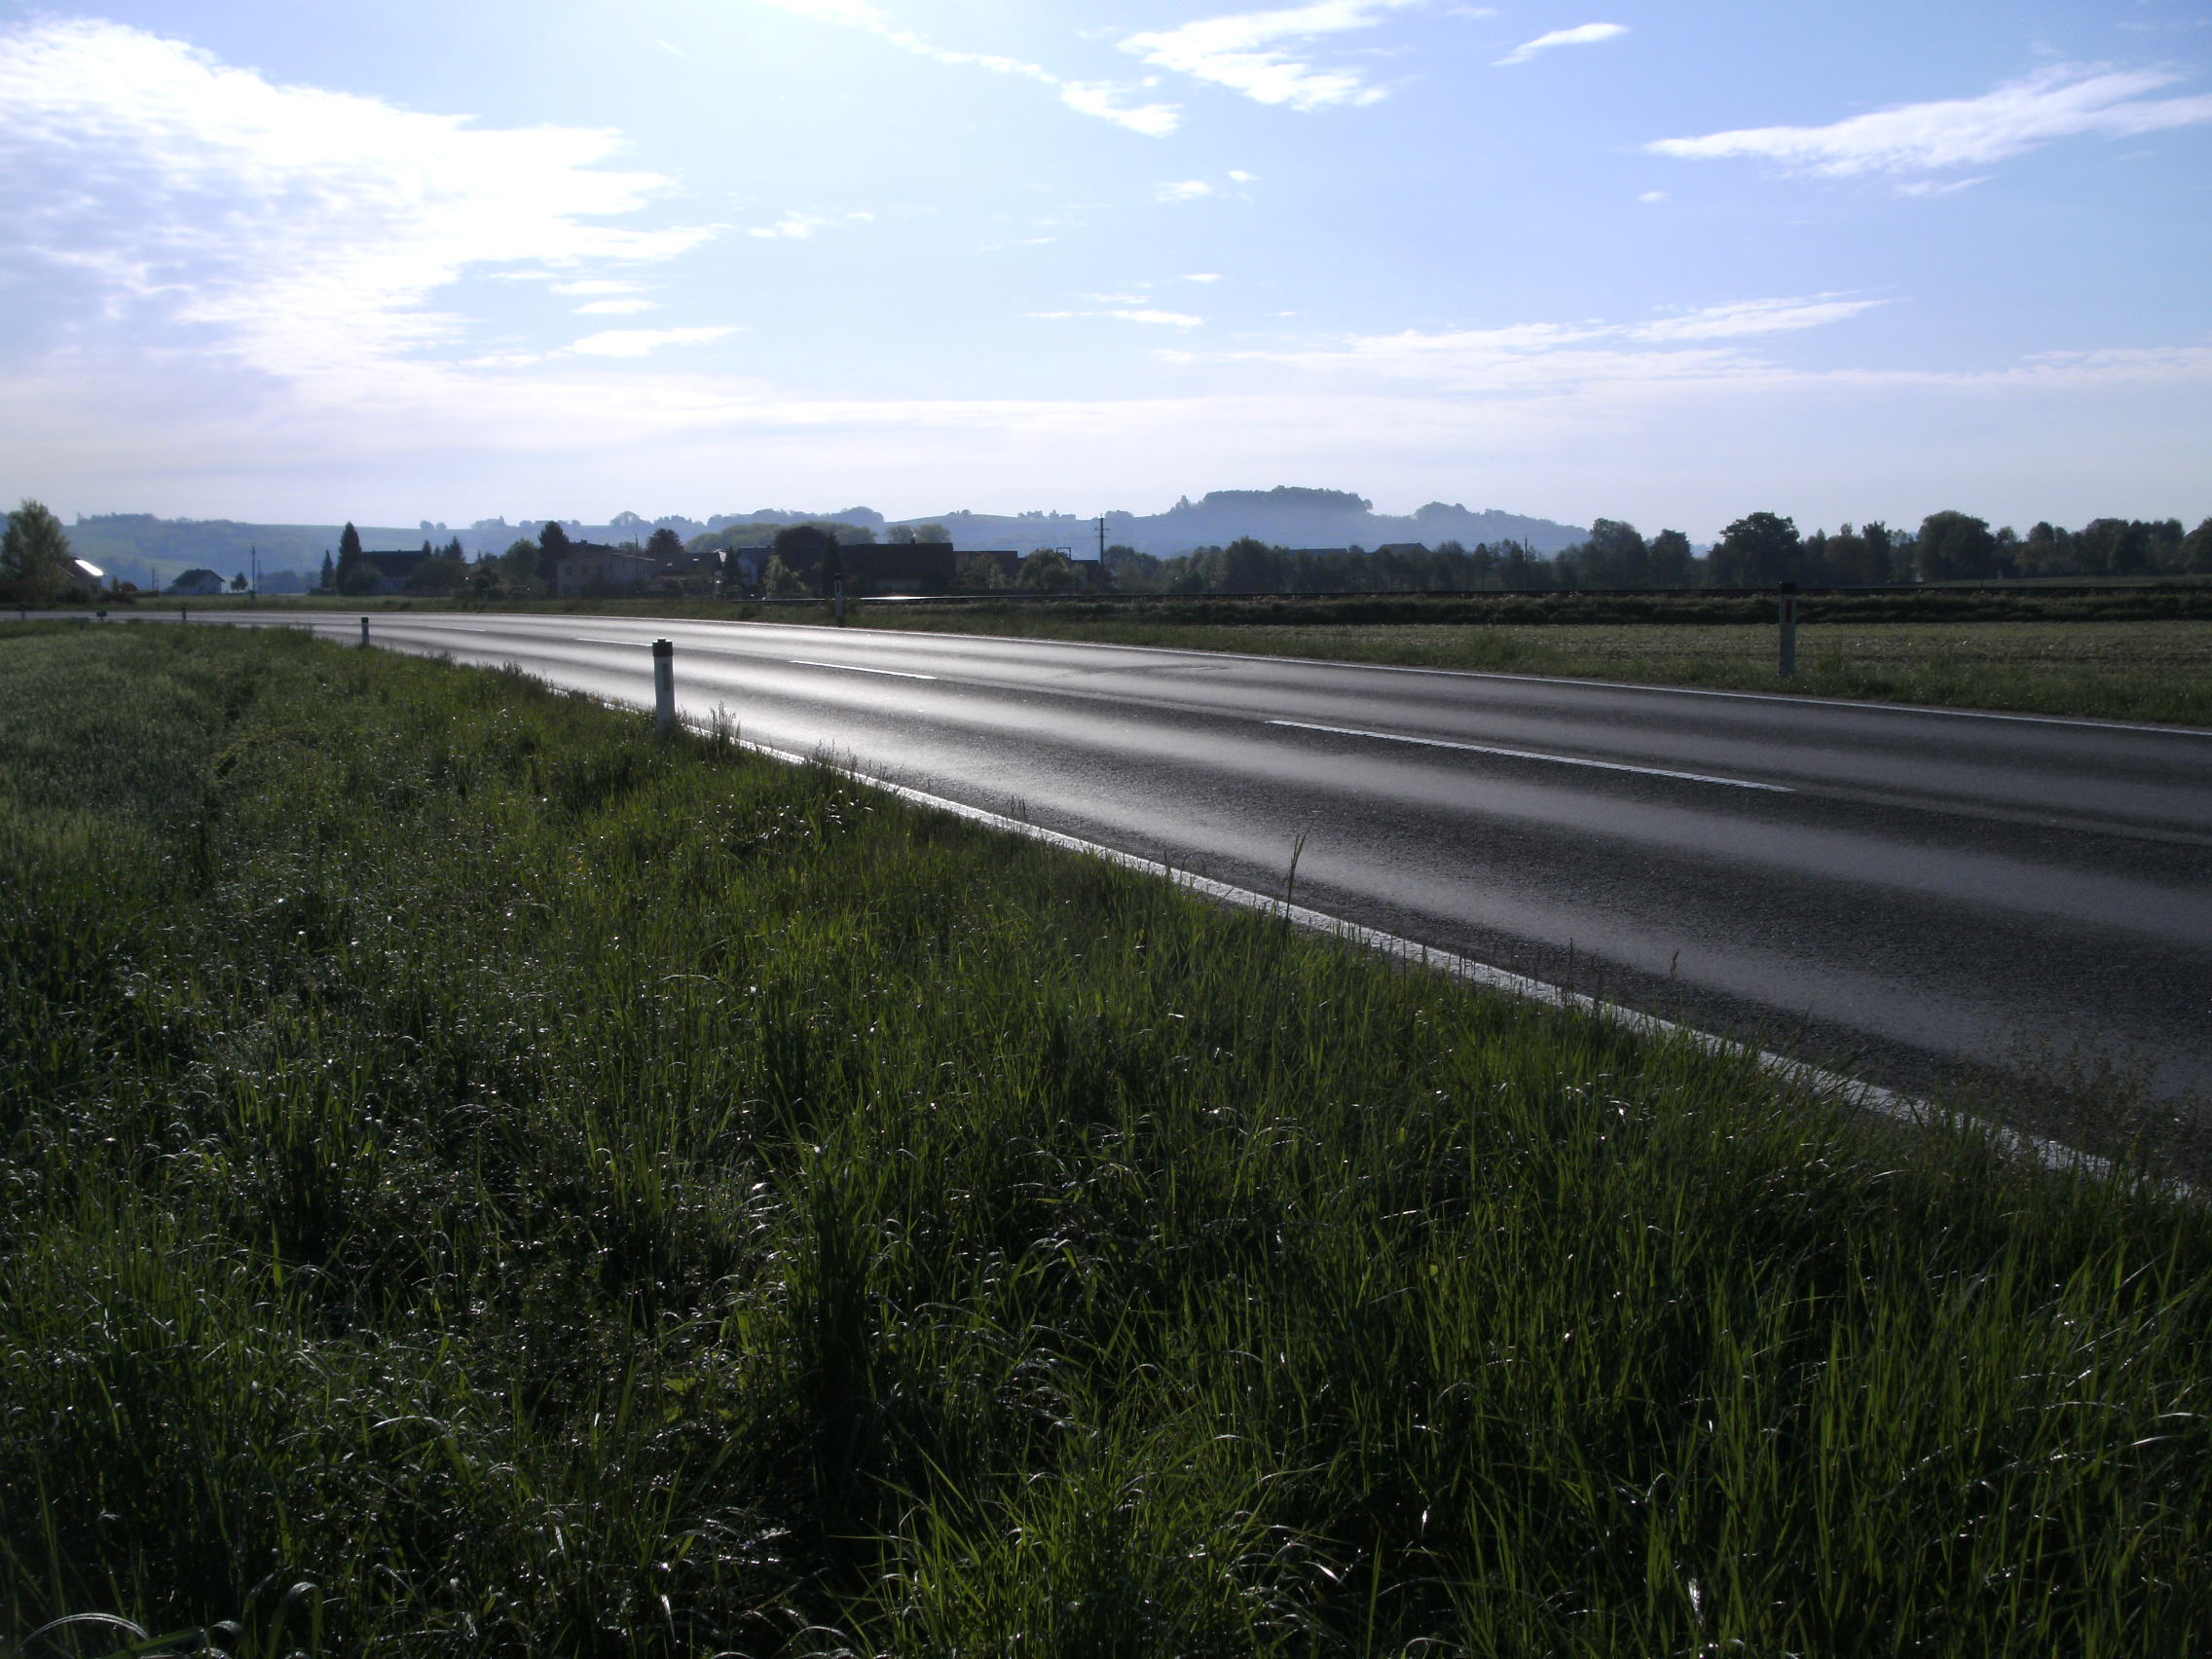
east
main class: Cropland
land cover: Barley
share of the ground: > 75 %
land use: Agriculture (excluding fallow land and kitchen gardens)
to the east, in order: Barley; Grassland without tree/shrub cover; Paved roads, cycling and walking lanes; Grassland without tree/shrub cover; Other bare soil; Grass margins; Railways; Grass margins; Common wheat
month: May
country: AT
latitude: 48.4219
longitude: 13.4452
